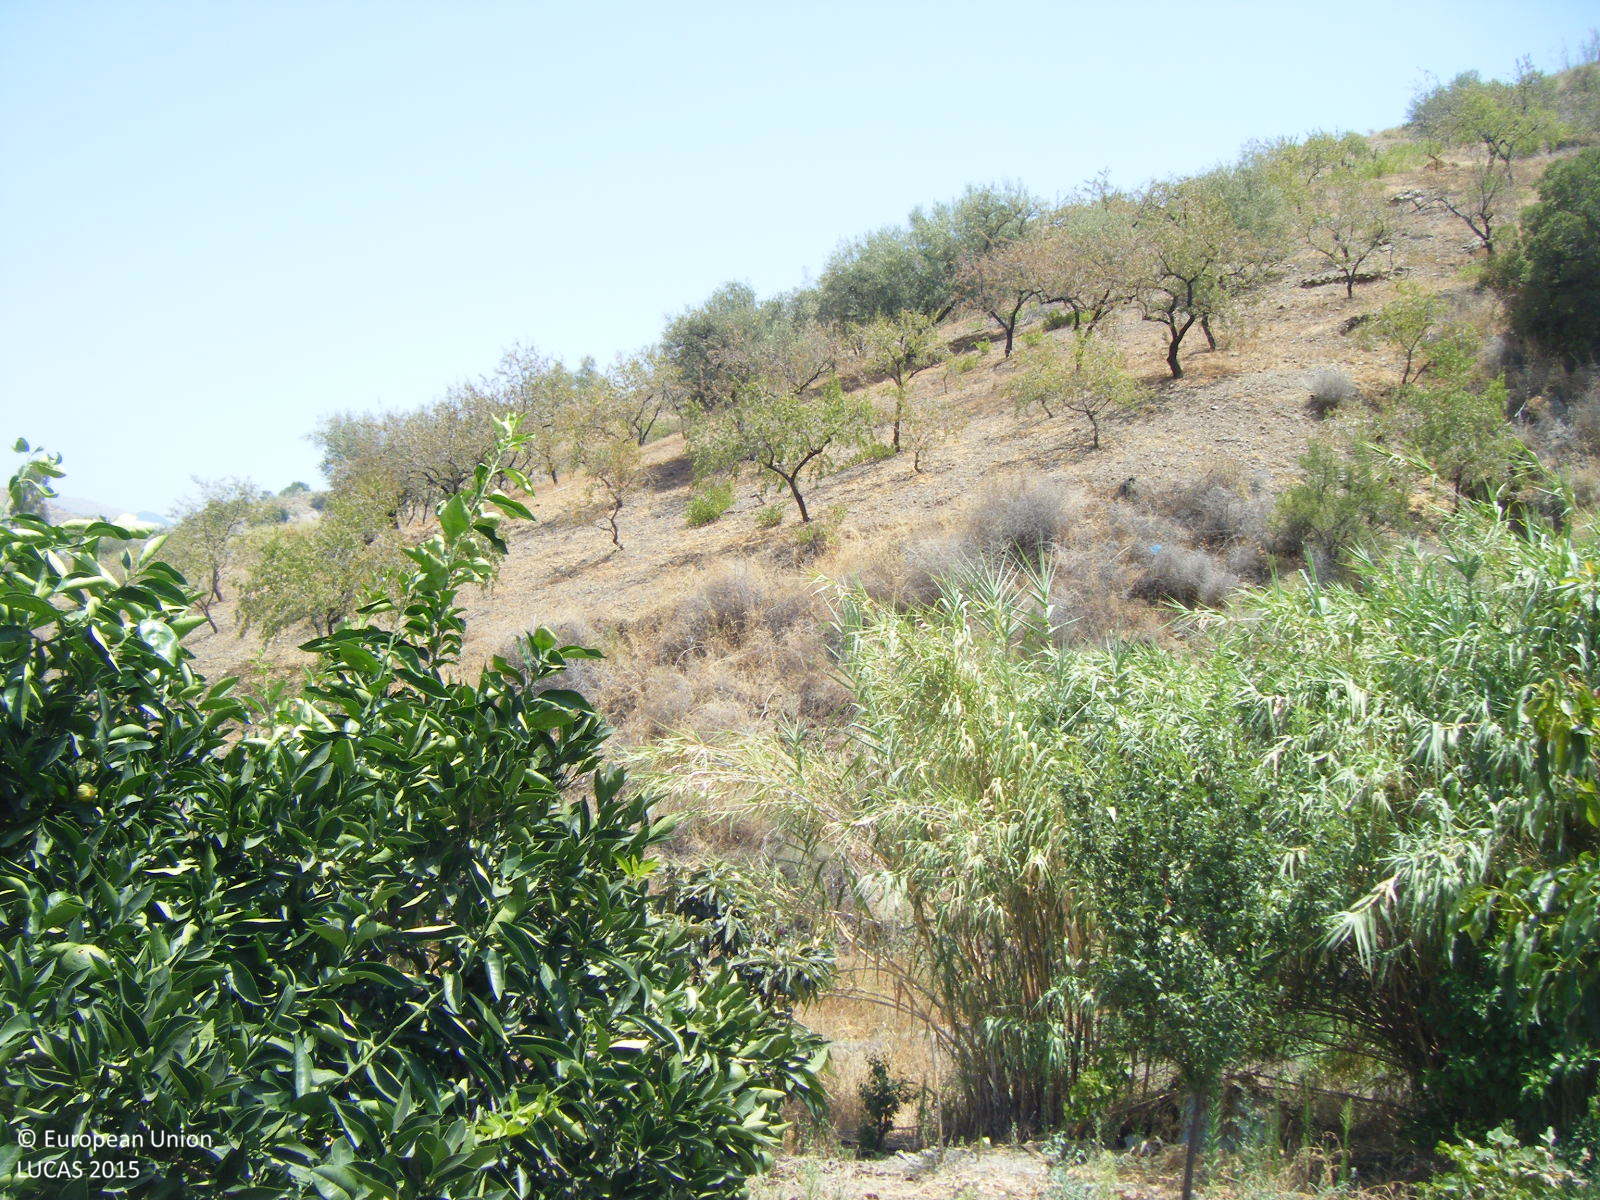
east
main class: Cropland
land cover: Oranges
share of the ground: 10 - 25 %
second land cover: Other bare soil
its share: > 75 %
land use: Kitchen garden
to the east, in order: Oranges; Other bare soil; Shruby margins; Rivers and streams; Shrubland without tree cover; Nuts trees; Rivers and streams; Shrubland without tree cover
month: July
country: ES
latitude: 36.8407
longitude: -4.0839
